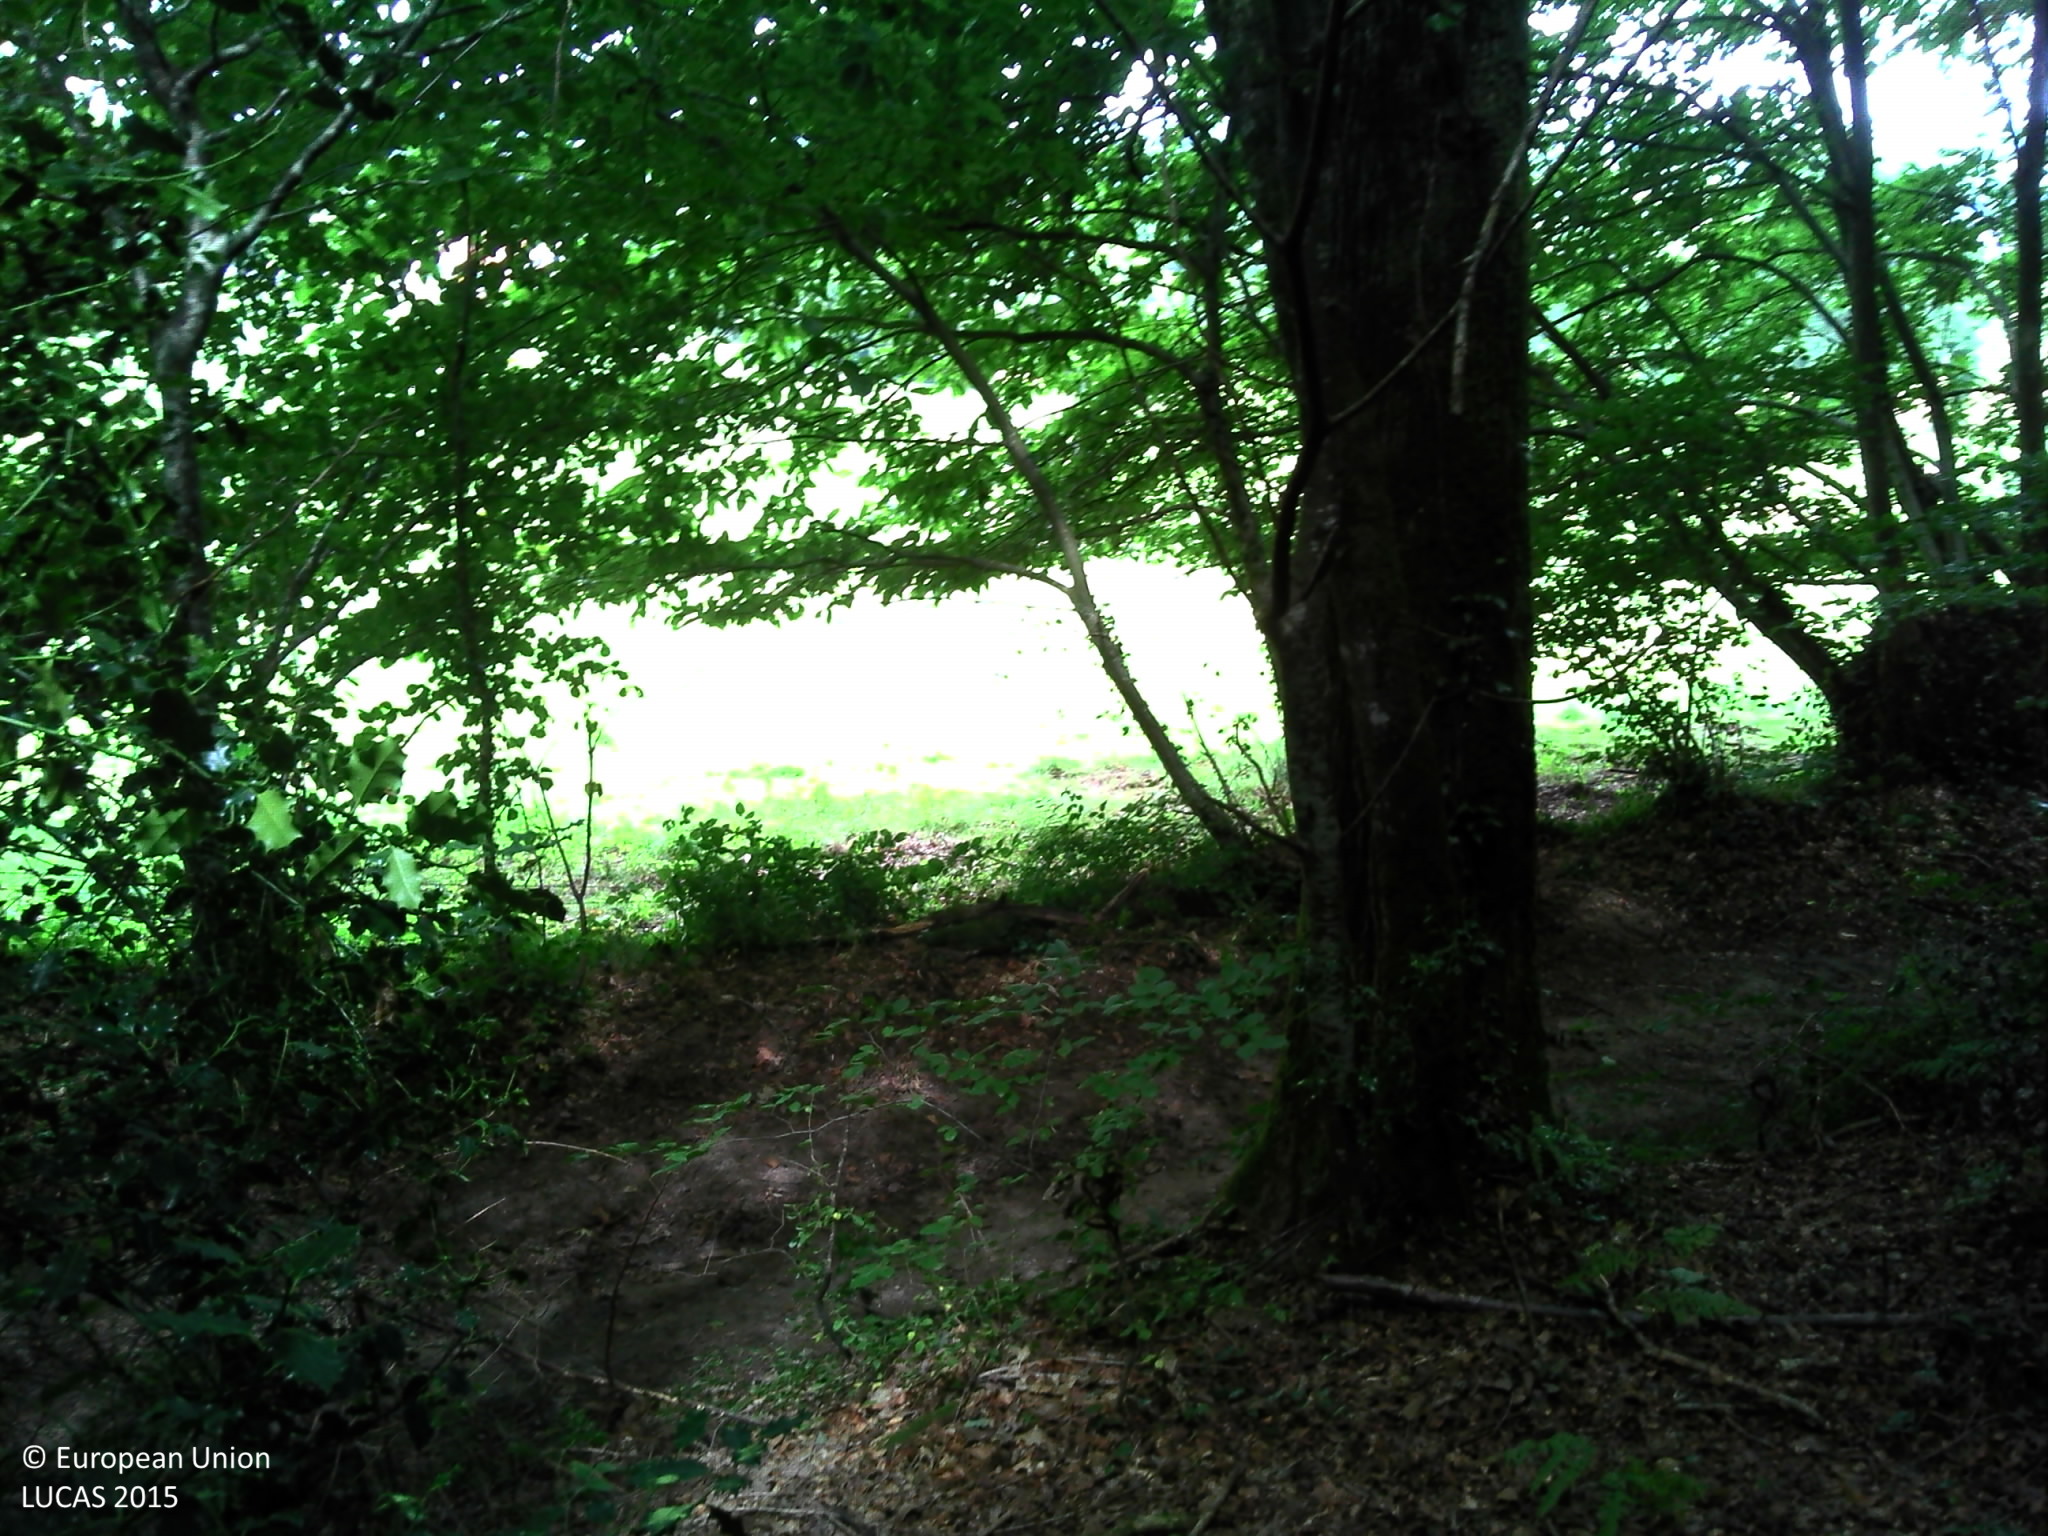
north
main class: Woodland
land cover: Broadleaved woodland
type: beech forest
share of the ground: > 75 %
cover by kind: broadleaved forest trees 95 %, shrubs 5 %
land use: Forestry
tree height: > 5 m
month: August
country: FR
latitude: 48.6961
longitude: -1.2806
